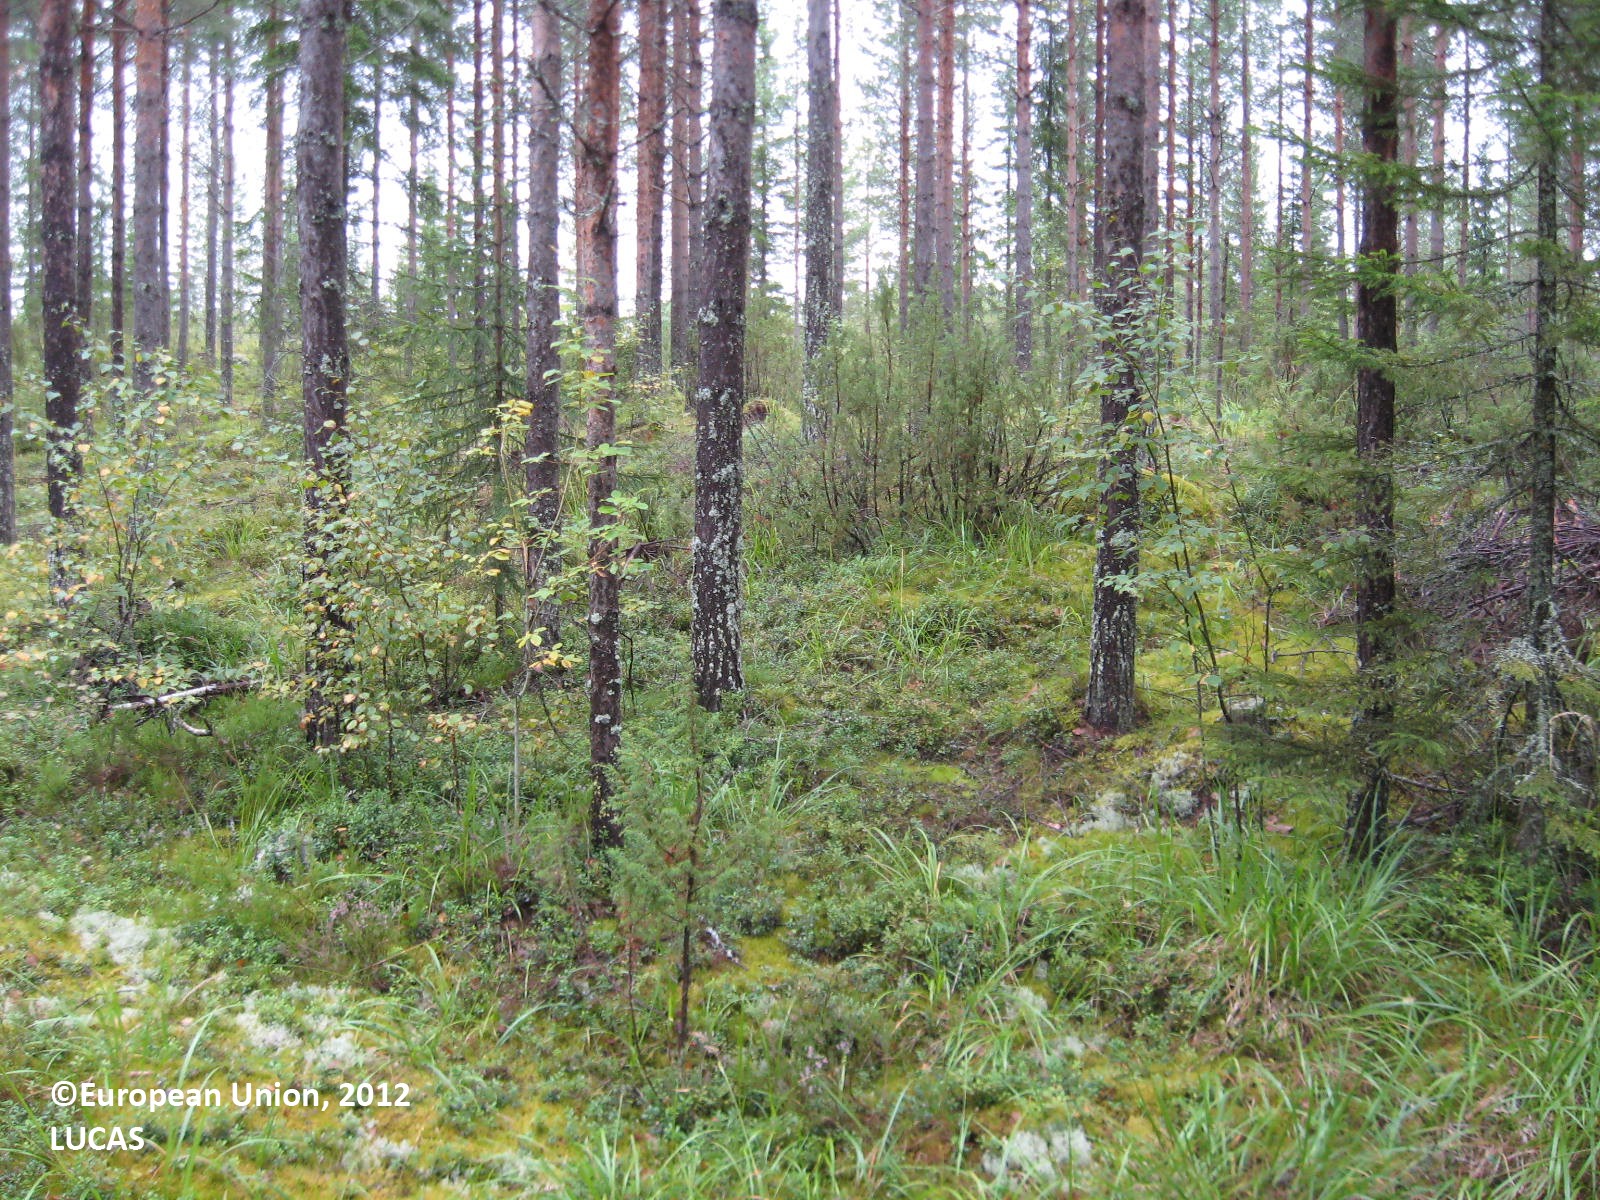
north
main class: Woodland
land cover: Pine dominated coniferous woodland
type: boreal forest
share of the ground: > 75 %
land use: Forestry
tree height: > 5 m
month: August
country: FI
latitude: 63.5104
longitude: 29.4564
